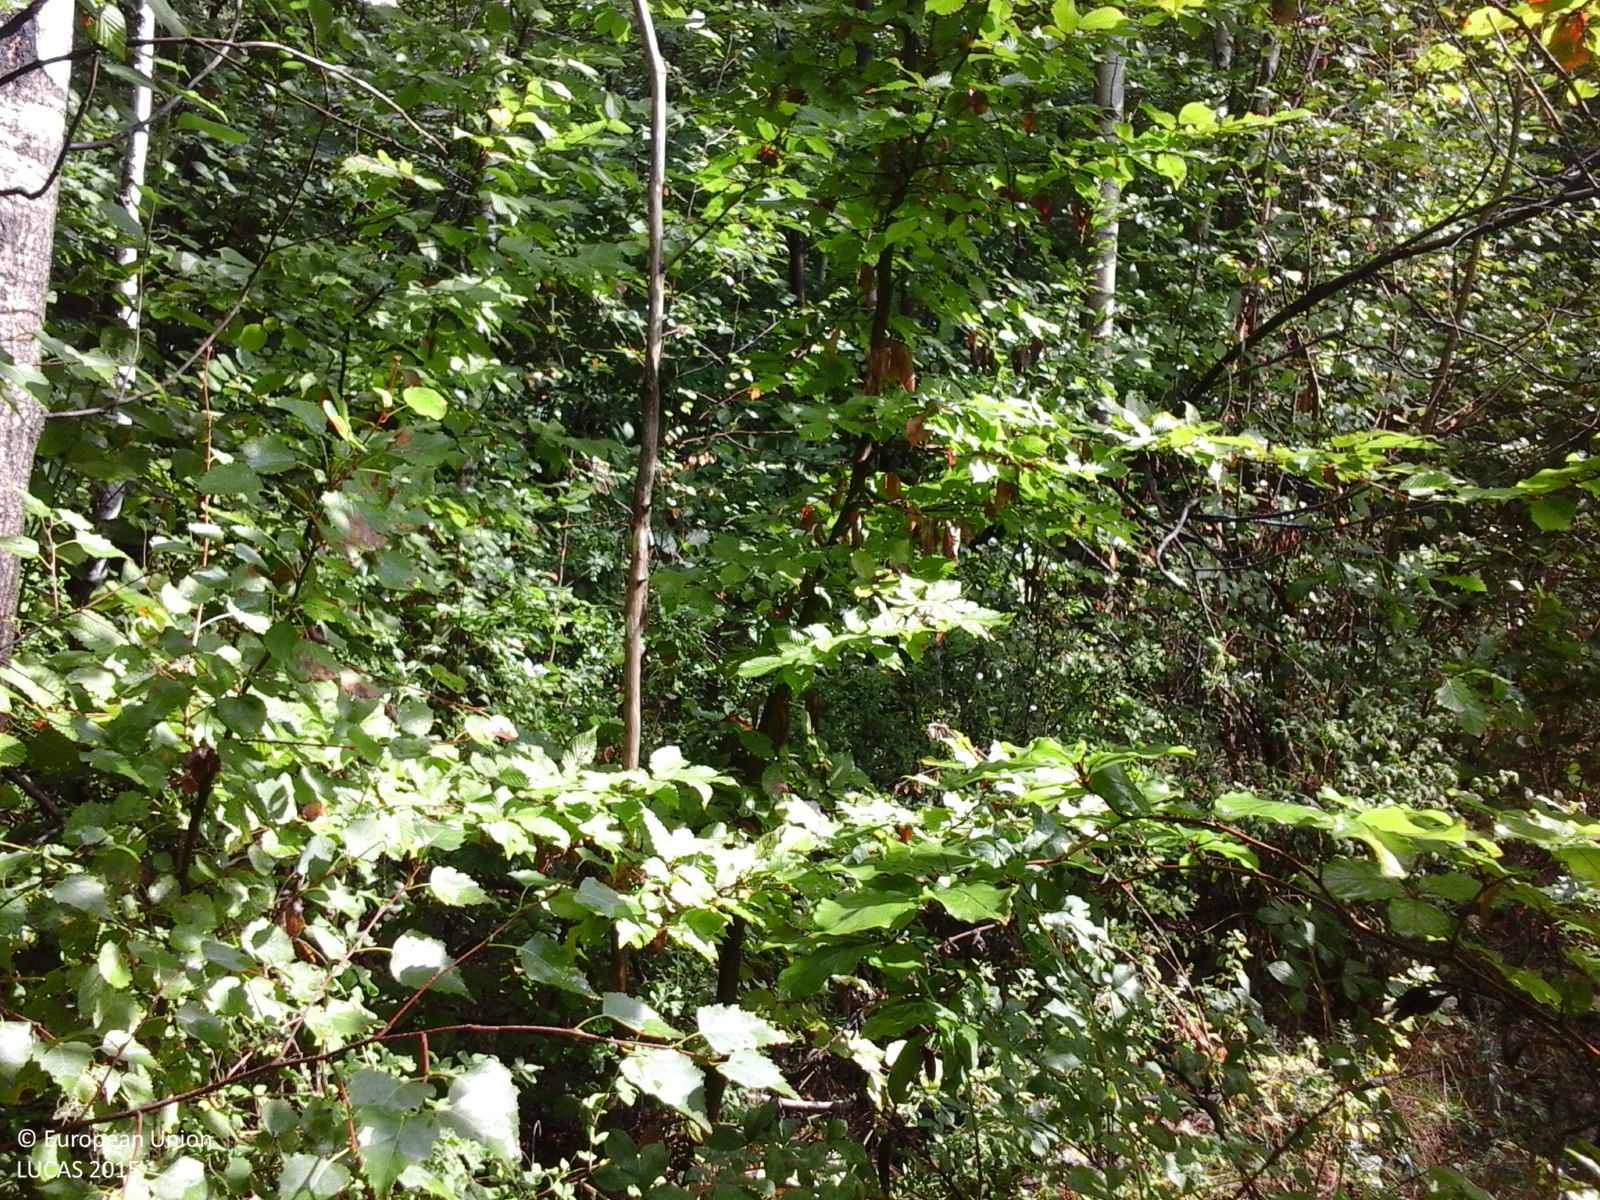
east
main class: Woodland
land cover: Broadleaved woodland
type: acidophilous oak and oak-birch forest
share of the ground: > 75 %
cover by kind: broadleaved forest trees 100 %
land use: Forestry
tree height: > 5 m
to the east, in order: Broadleaved woodland; Tracks; Broadleaved woodland; Tracks; Broadleaved woodland
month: September
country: RO
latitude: 45.2241
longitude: 24.5328
